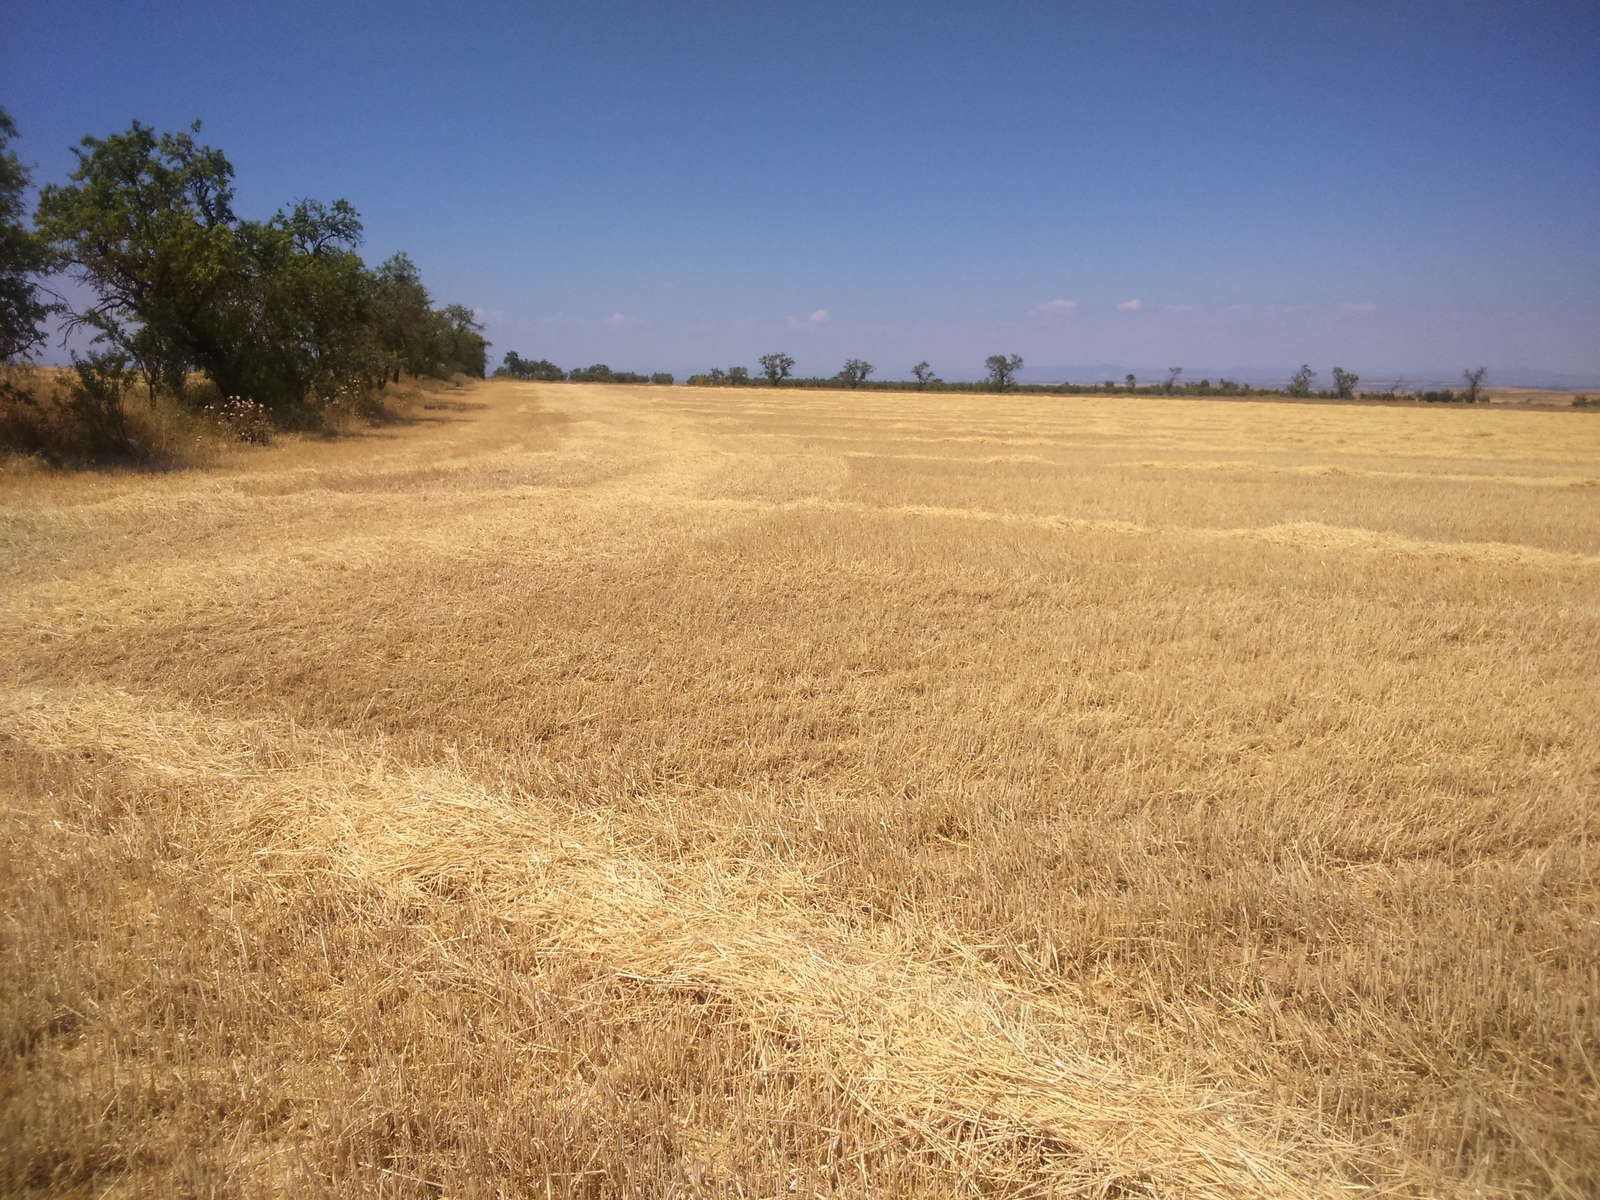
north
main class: Cropland
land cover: Barley
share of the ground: < 10 %
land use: Agriculture (excluding fallow land and kitchen gardens)
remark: Harvested field
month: June
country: ES
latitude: 41.6004
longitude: 0.0626
